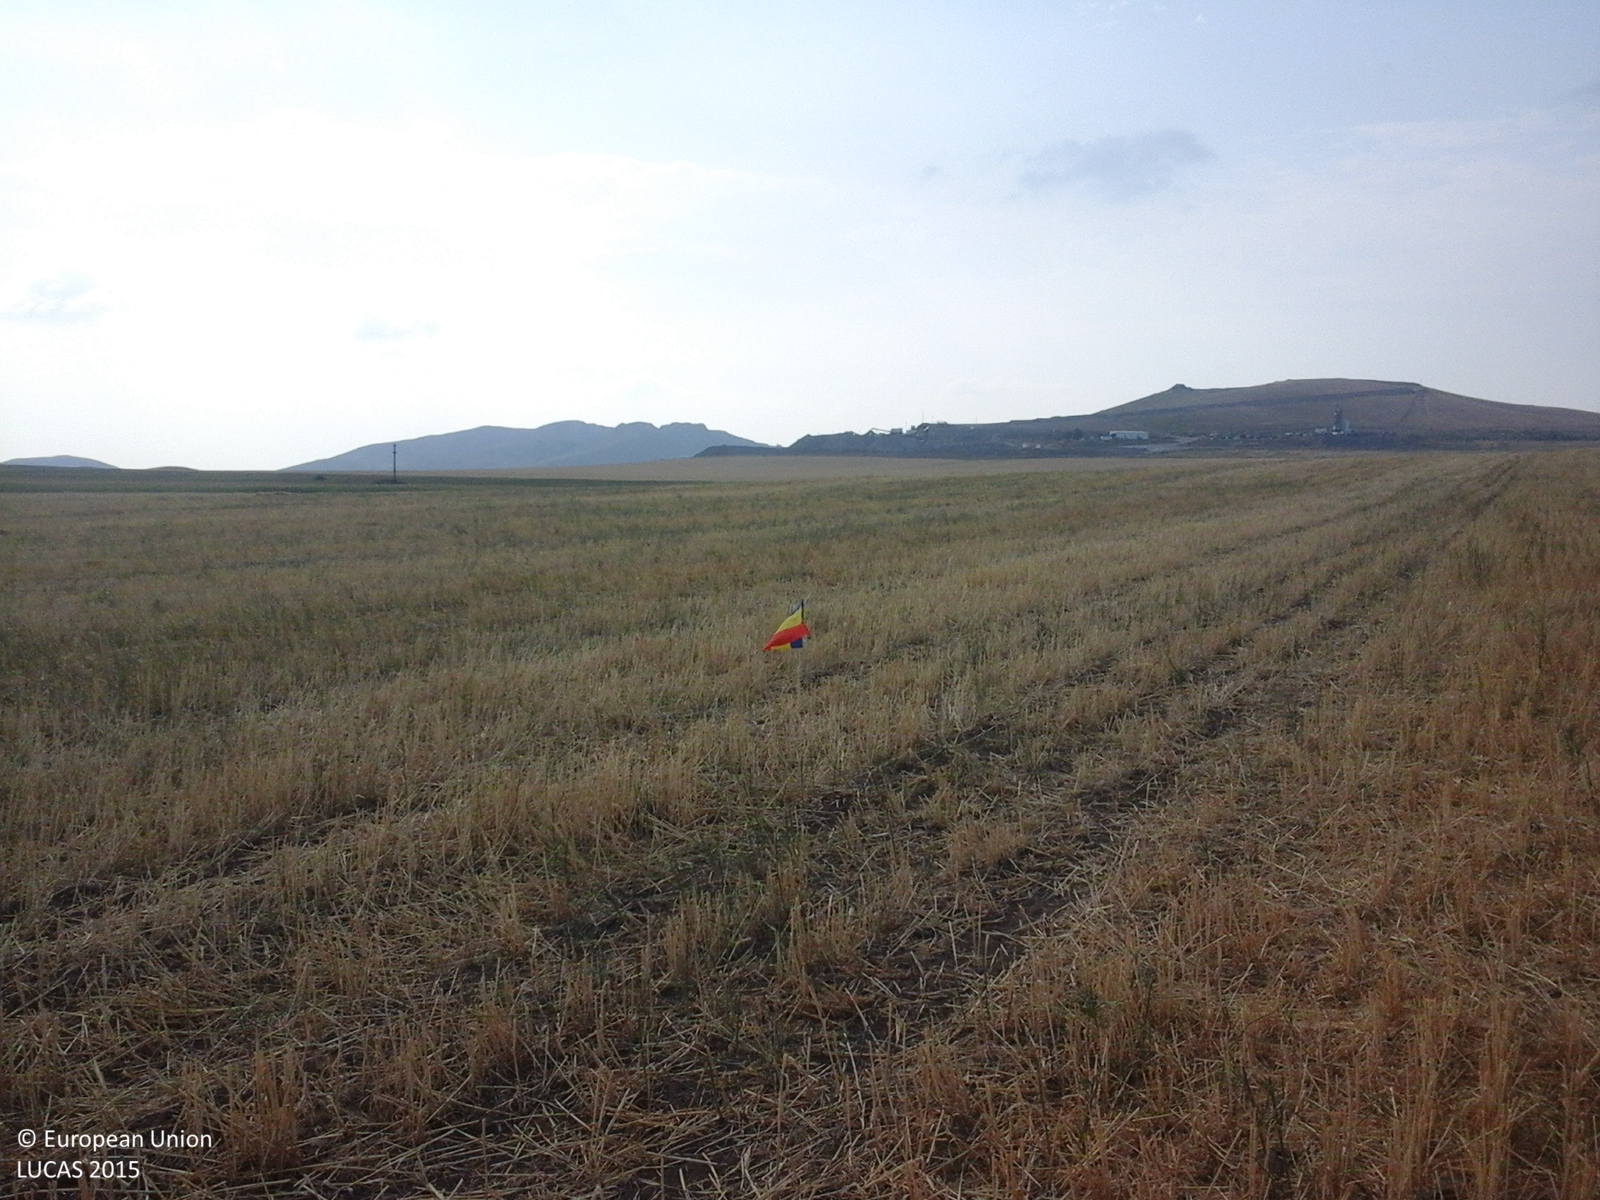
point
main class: Cropland
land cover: Common wheat
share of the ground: > 75 %
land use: Agriculture (excluding fallow land and kitchen gardens)
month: July
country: RO
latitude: 45.0950
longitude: 28.2545
